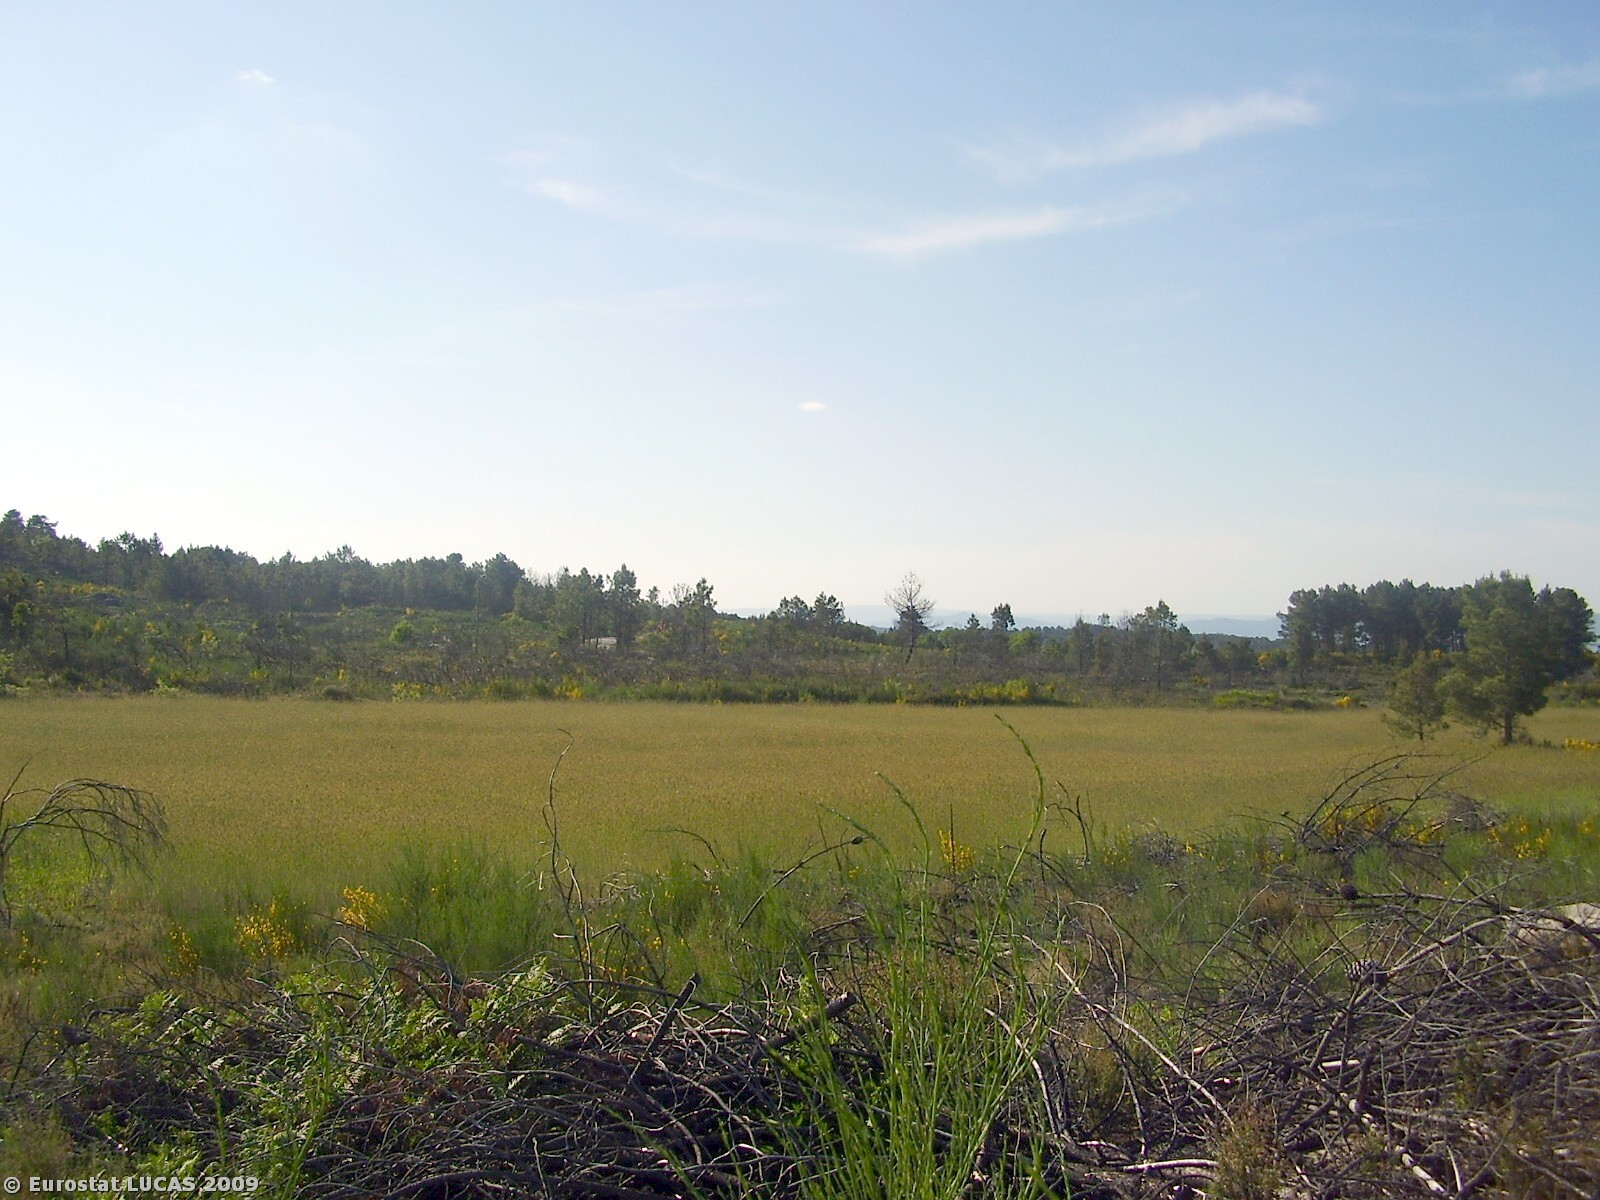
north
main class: Shrubland
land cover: Shrubland without tree cover
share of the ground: > 75 %
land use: Unused
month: May
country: PT
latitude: 41.2542
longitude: -7.2427
